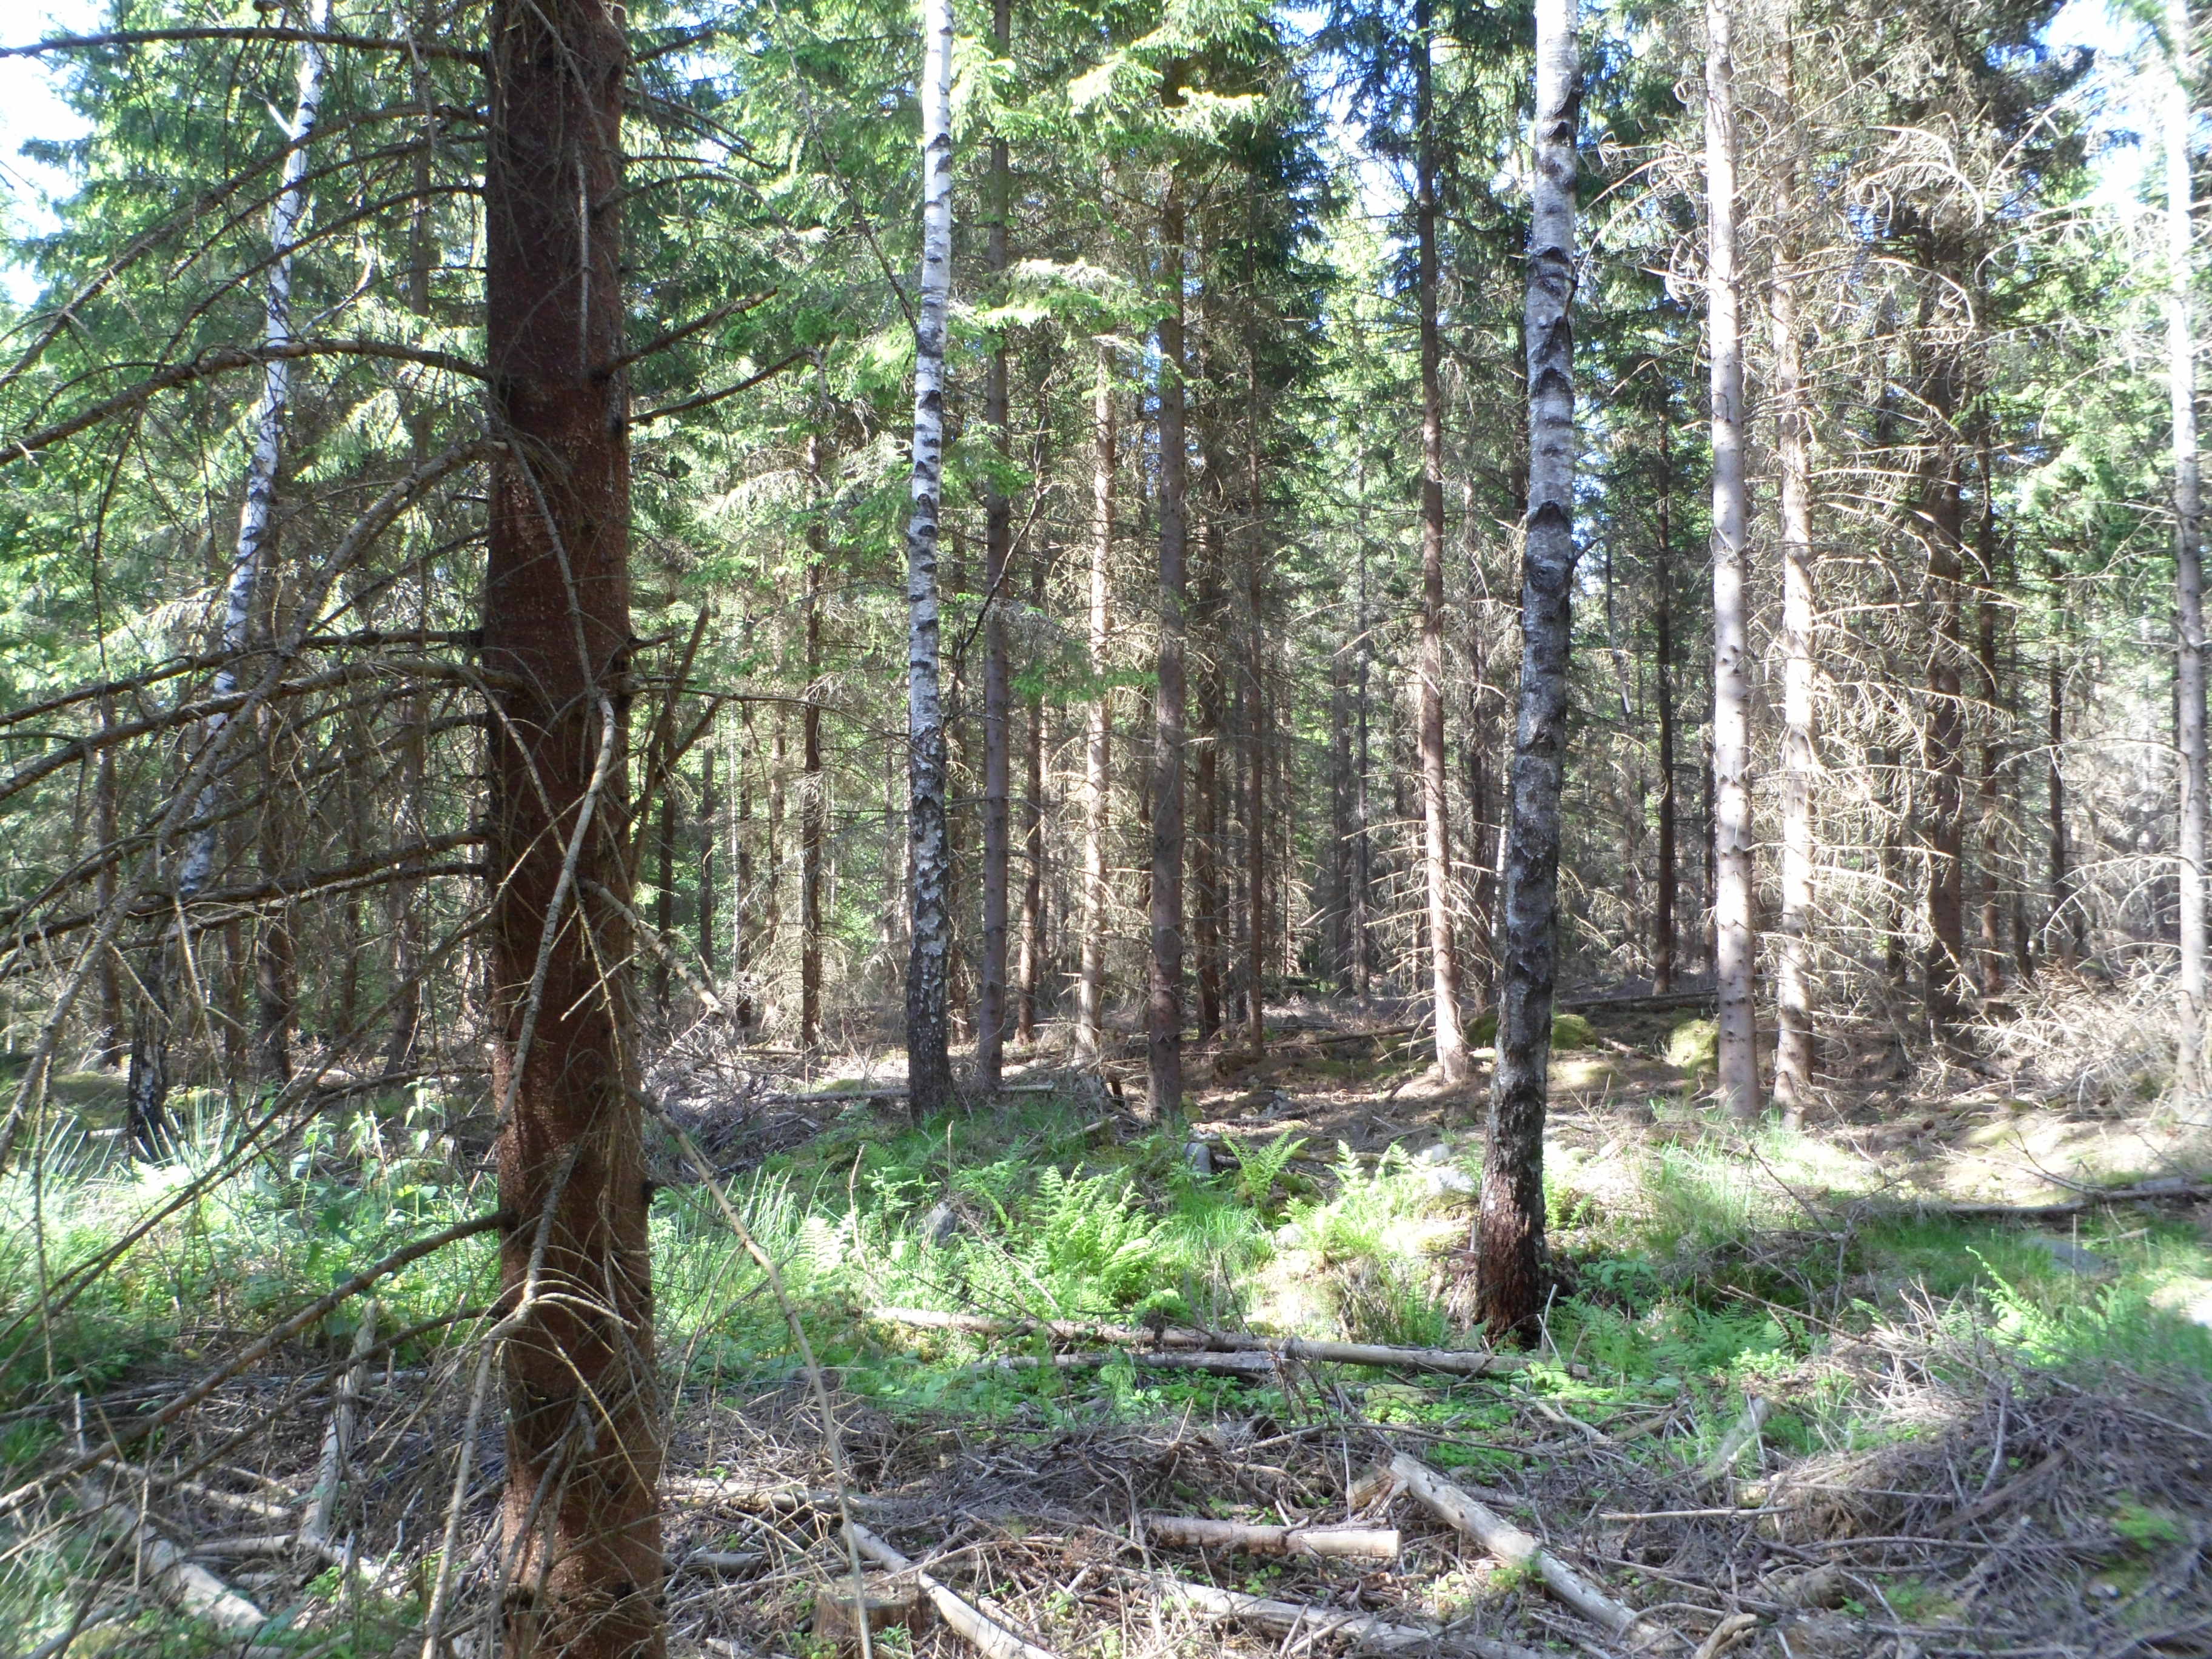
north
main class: Woodland
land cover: Spruce dominated coniferous woodland
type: boreal forest
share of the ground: 50 - 75 %
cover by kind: coniferous forest trees 65 %, lichens and mosses 25 %, broadleaved forest trees 5 %, herbaceous plants 5 %
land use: Forestry
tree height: > 5 m
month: June
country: SE
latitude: 56.9609
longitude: 14.8484
